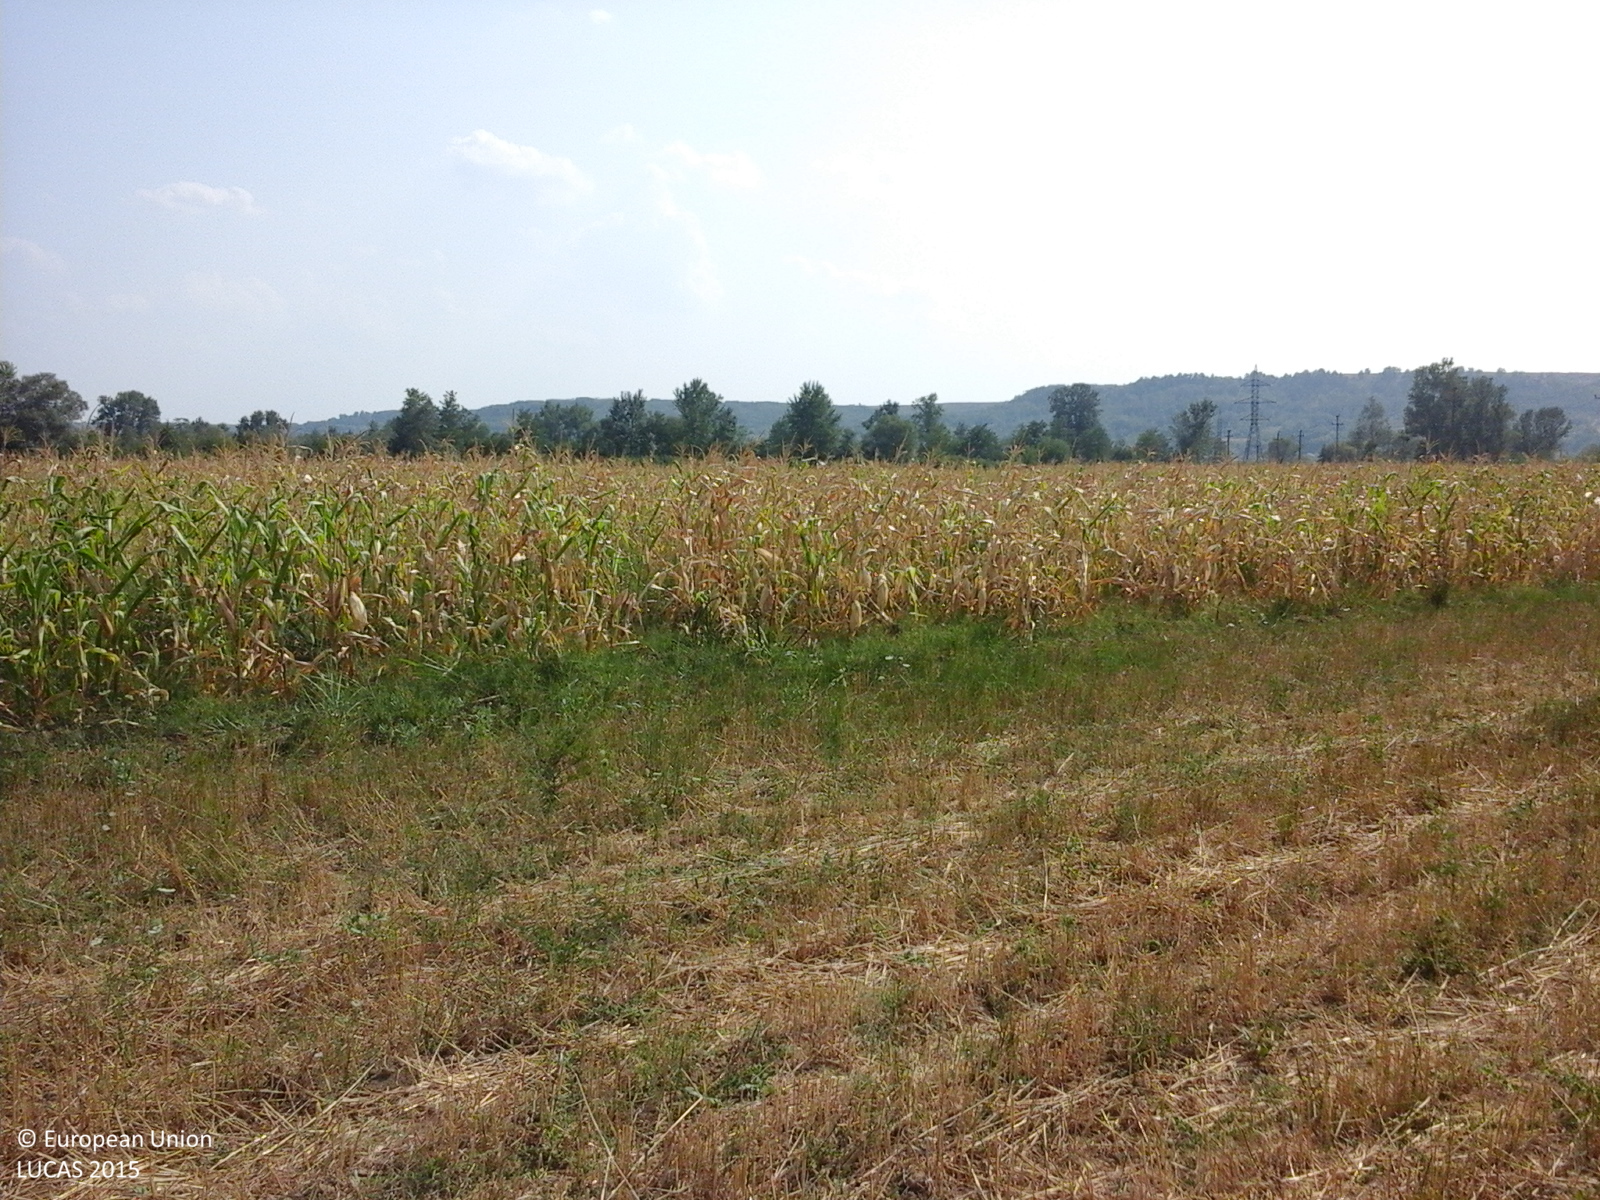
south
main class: Cropland
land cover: Common wheat
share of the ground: > 75 %
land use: Agriculture (excluding fallow land and kitchen gardens)
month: August
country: RO
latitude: 44.5436
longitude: 23.4830
